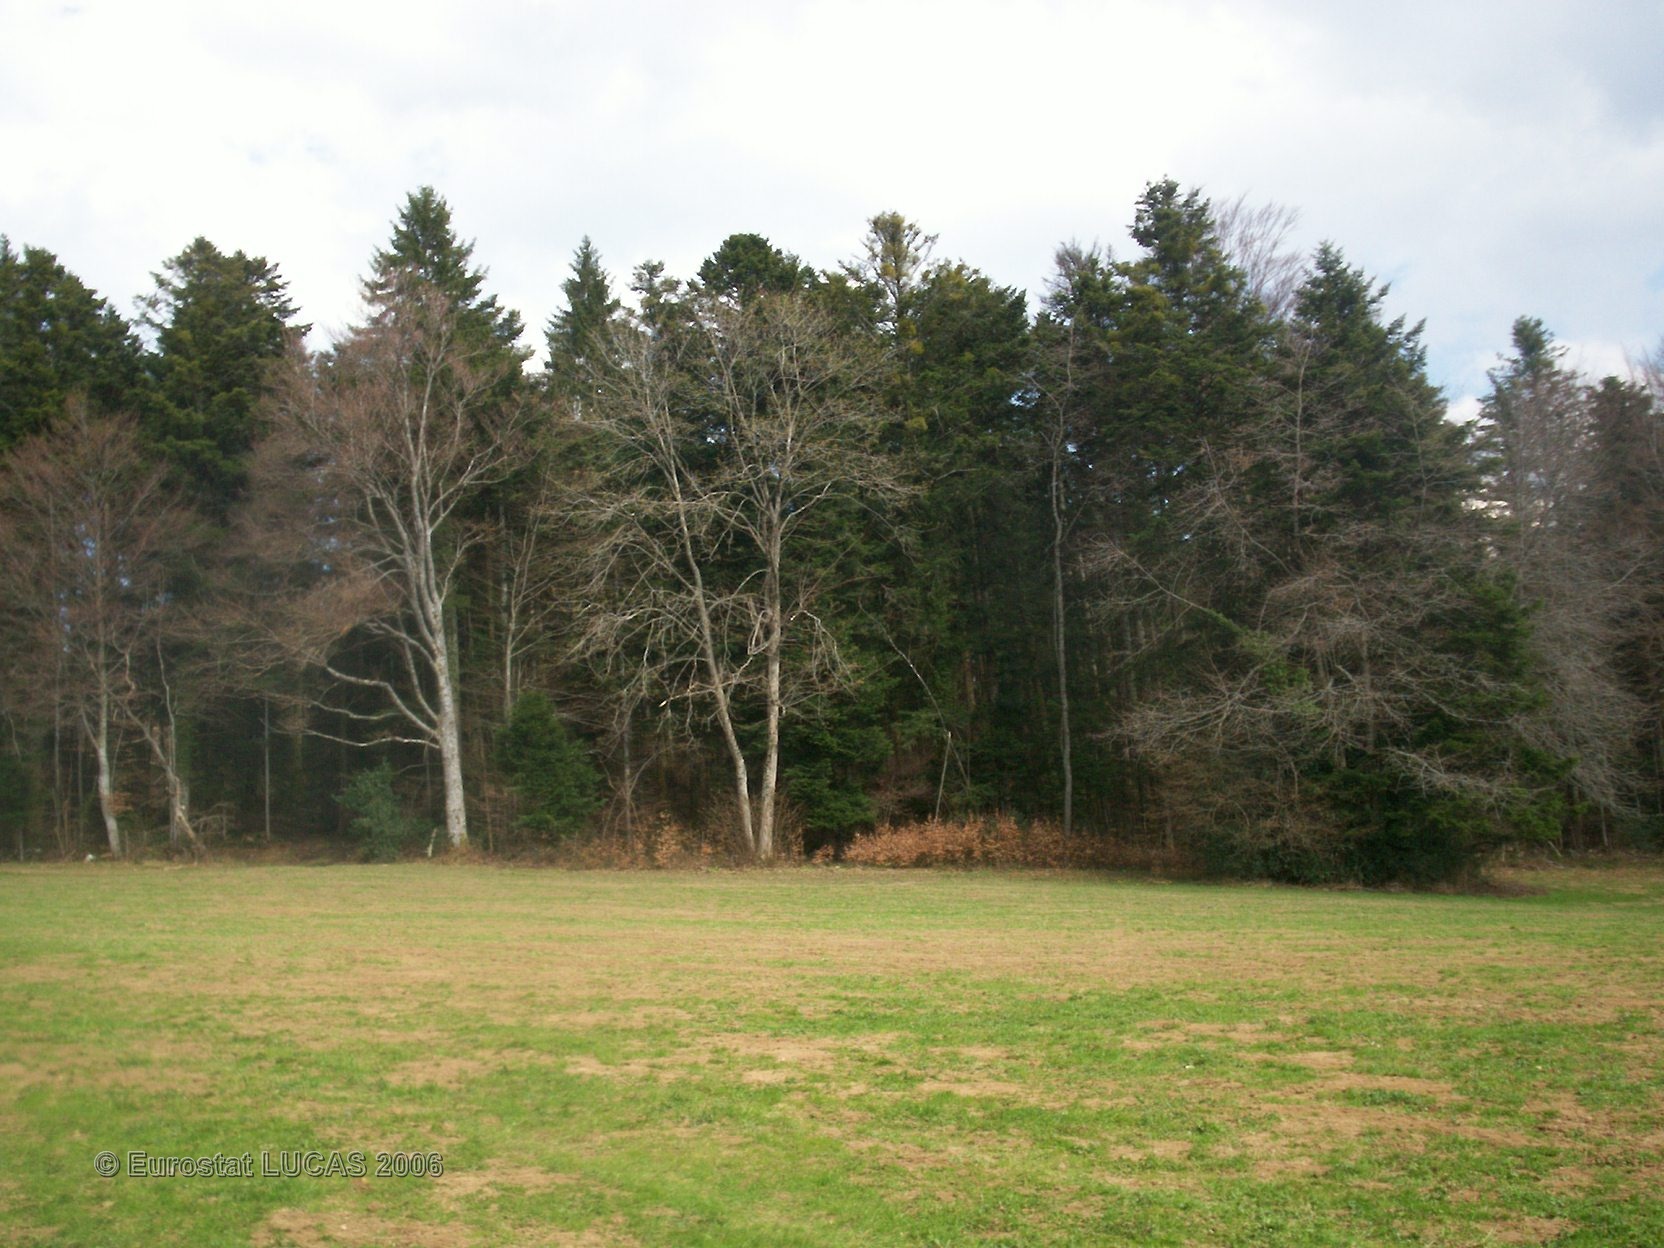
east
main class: Grassland
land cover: Grassland without tree/shrub cover
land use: Agriculture (excluding fallow land and kitchen gardens)
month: April
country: FR
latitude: 47.3160
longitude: 6.9195
